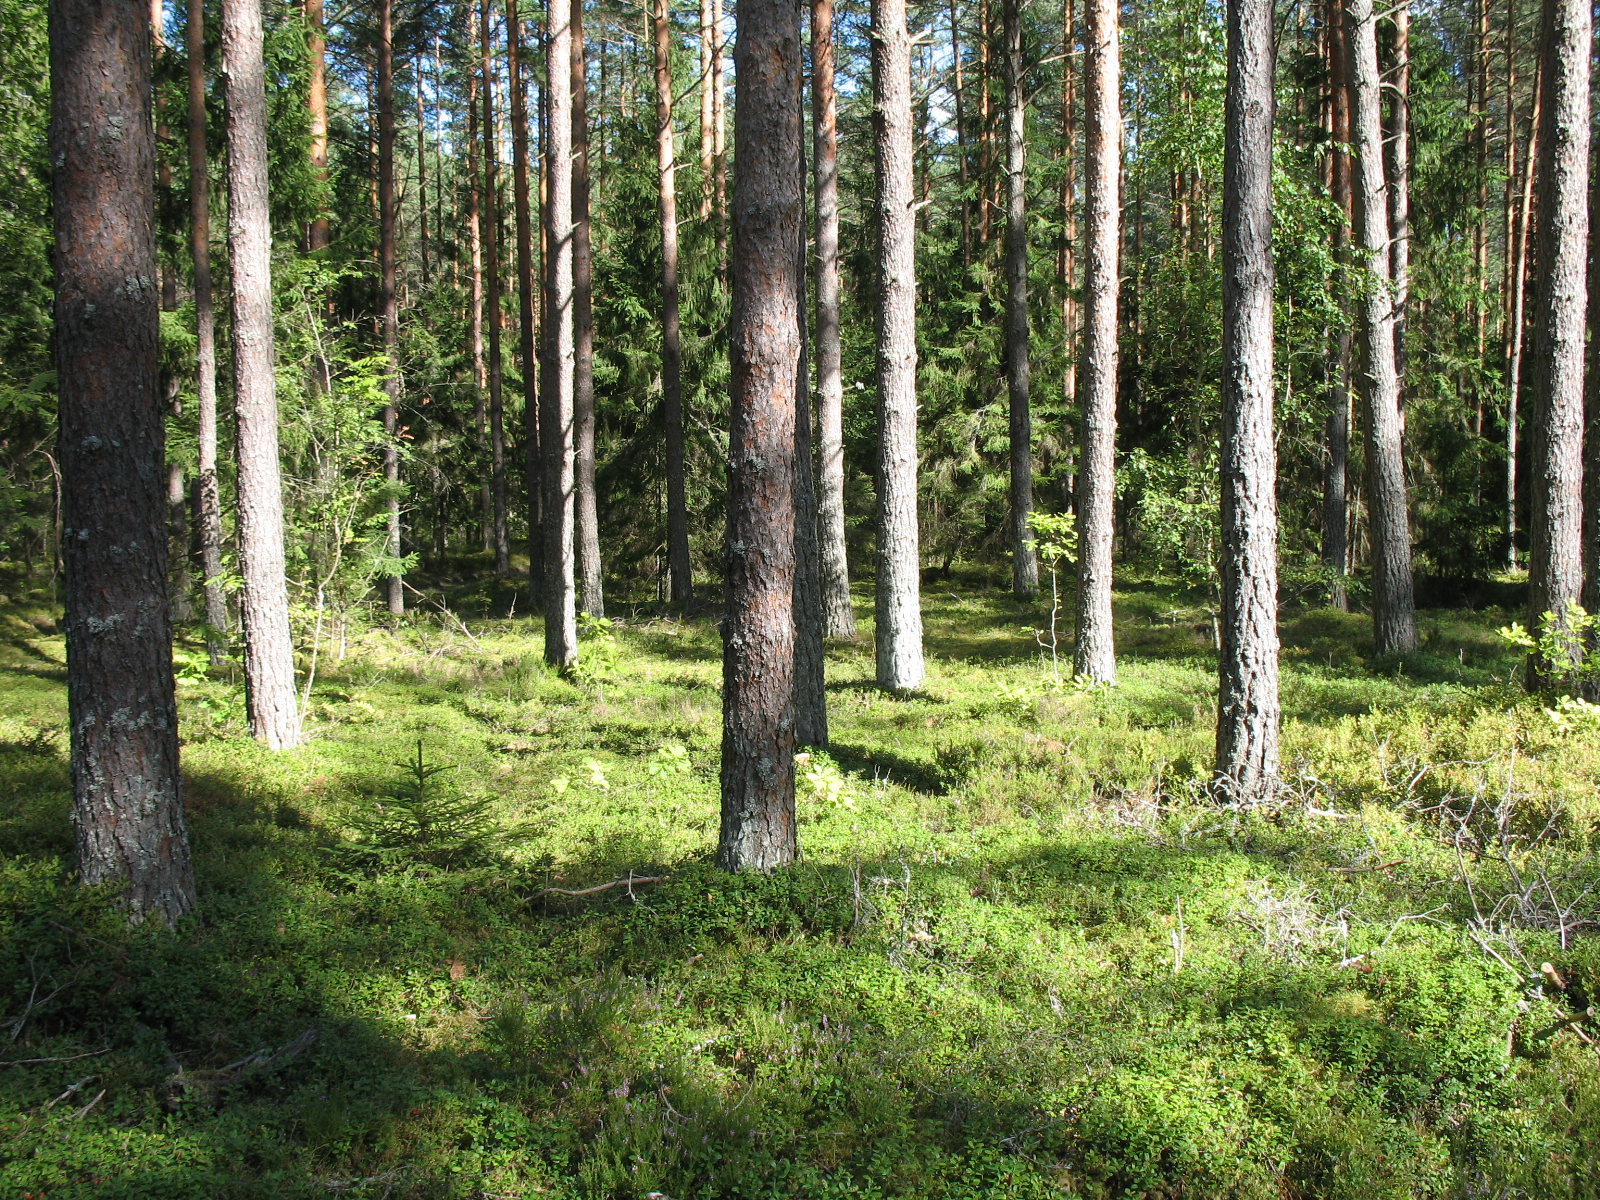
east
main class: Woodland
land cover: Pine dominated coniferous woodland
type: hemiboreal forest and nemoral coniferous forest and mixed broadleaved-coniferous forest
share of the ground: 25 - 50 %
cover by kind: coniferous forest trees 30 %, lichens and mosses 30 %, herbaceous plants 20 %, shrubs 10 %, unconsolidated bare surface 10 %
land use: Forestry
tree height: > 5 m
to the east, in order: Pine dominated coniferous woodland; Tracks; Pine dominated coniferous woodland; Other coniferous woodland
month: August
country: LV
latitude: 56.5458
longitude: 25.4567
